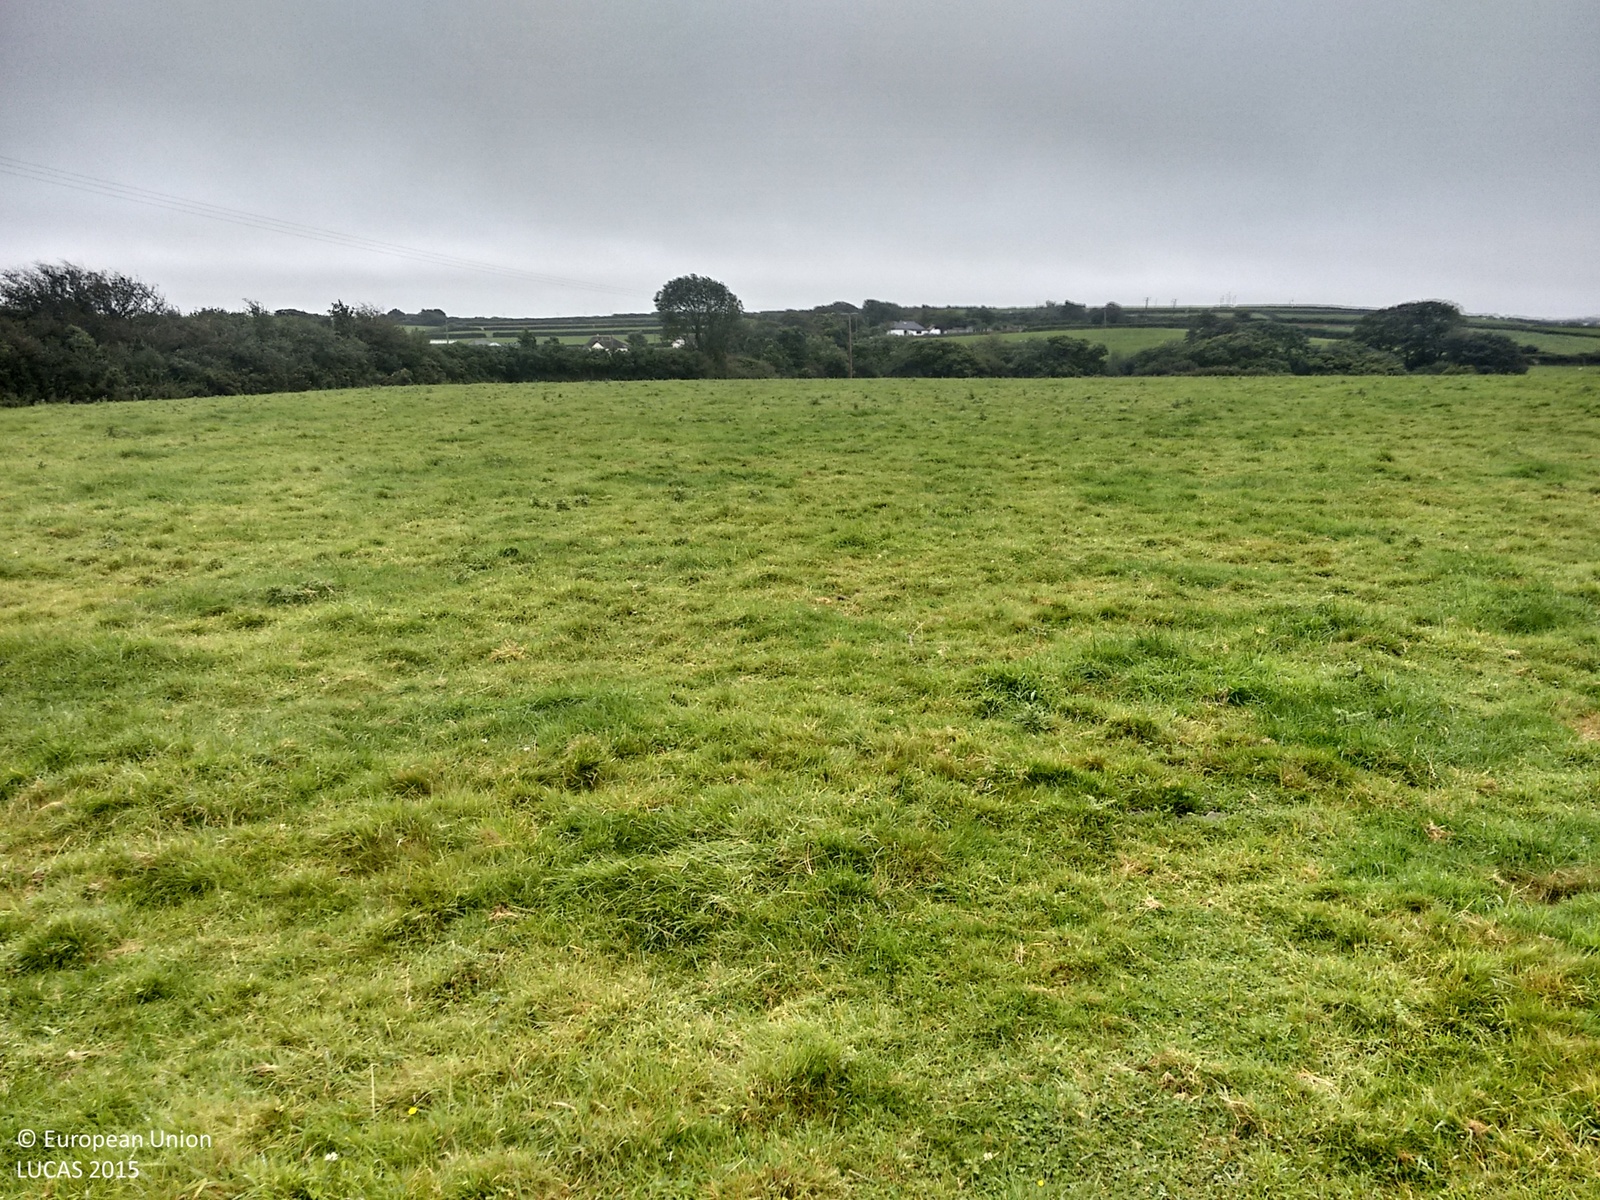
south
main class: Grassland
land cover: Grassland without tree/shrub cover
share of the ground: > 75 %
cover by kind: herbaceous plants 100 %
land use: Agriculture (excluding fallow land and kitchen gardens)
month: August
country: GB
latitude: 50.0803
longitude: -5.1411
